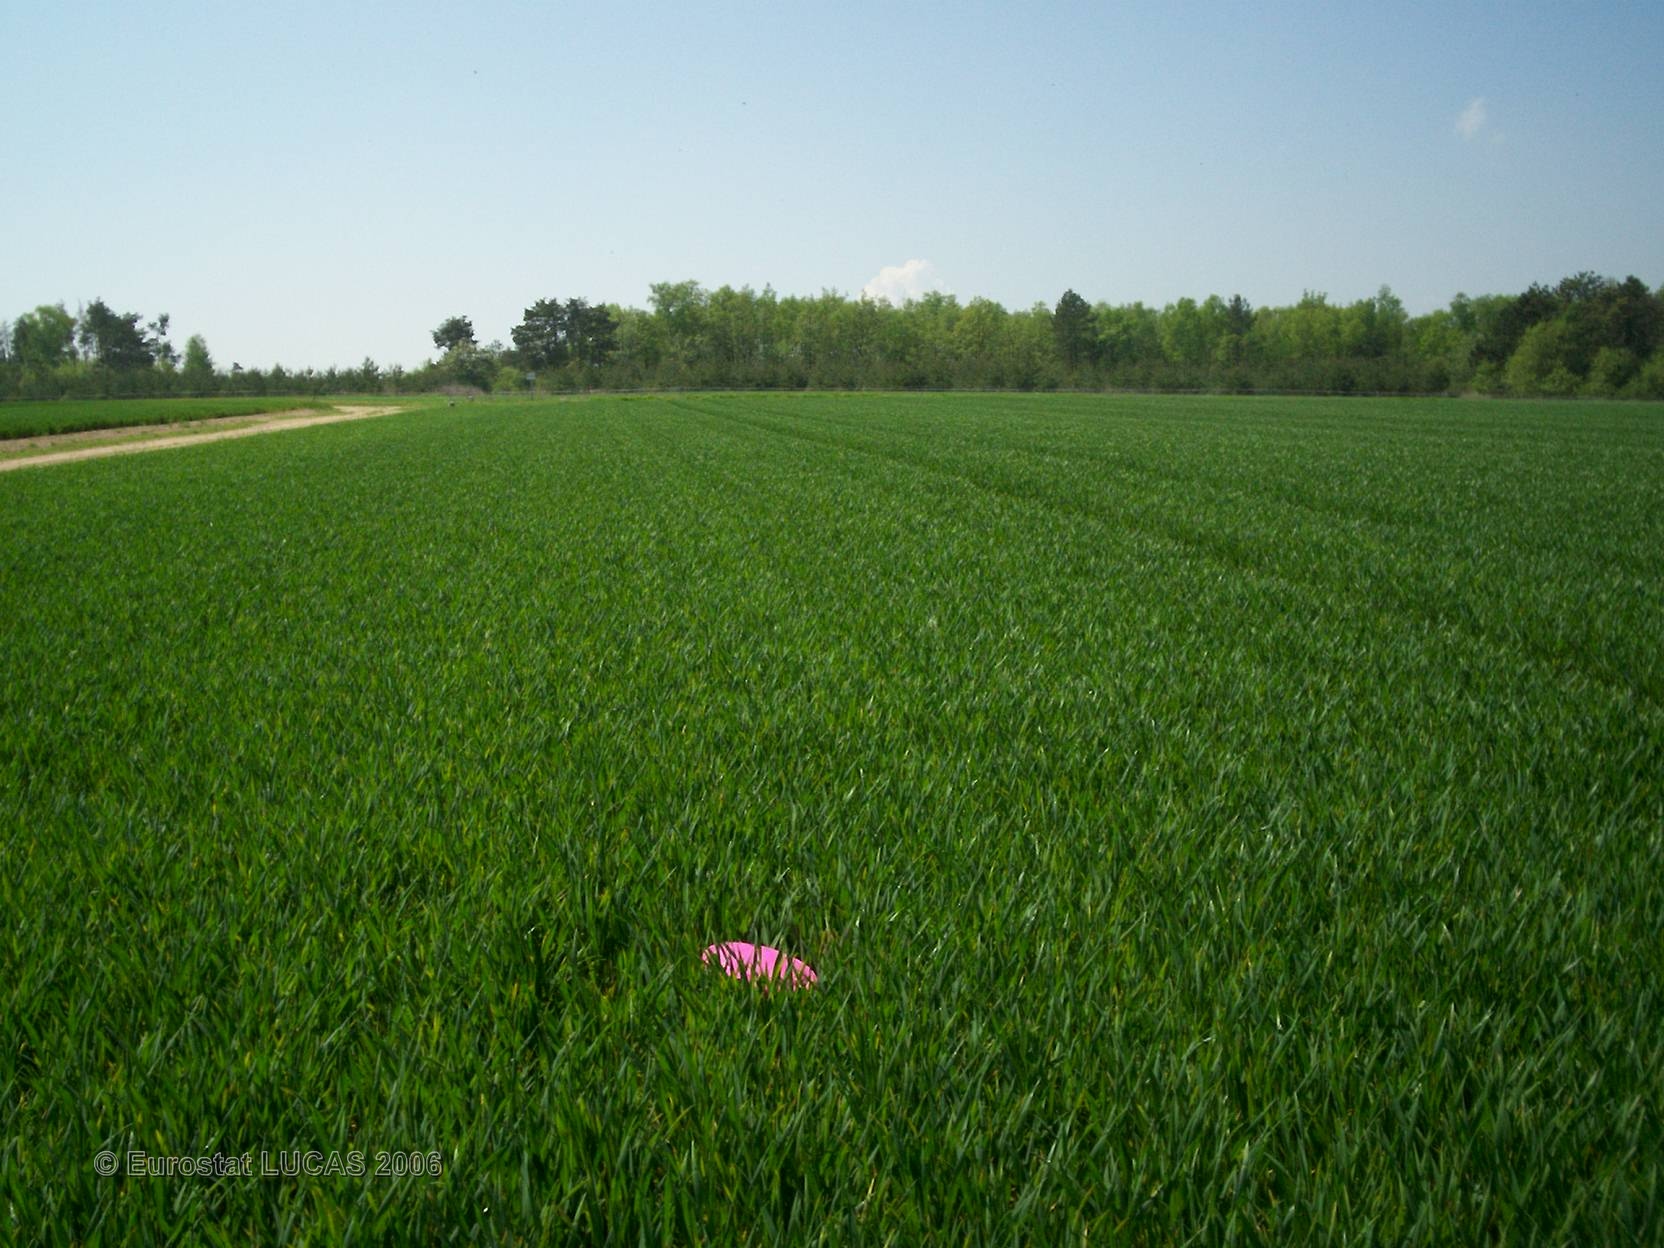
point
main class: Cropland
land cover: Common wheat
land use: Agriculture (excluding fallow land and kitchen gardens)
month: May
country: FR
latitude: 49.2509
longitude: 4.3496
